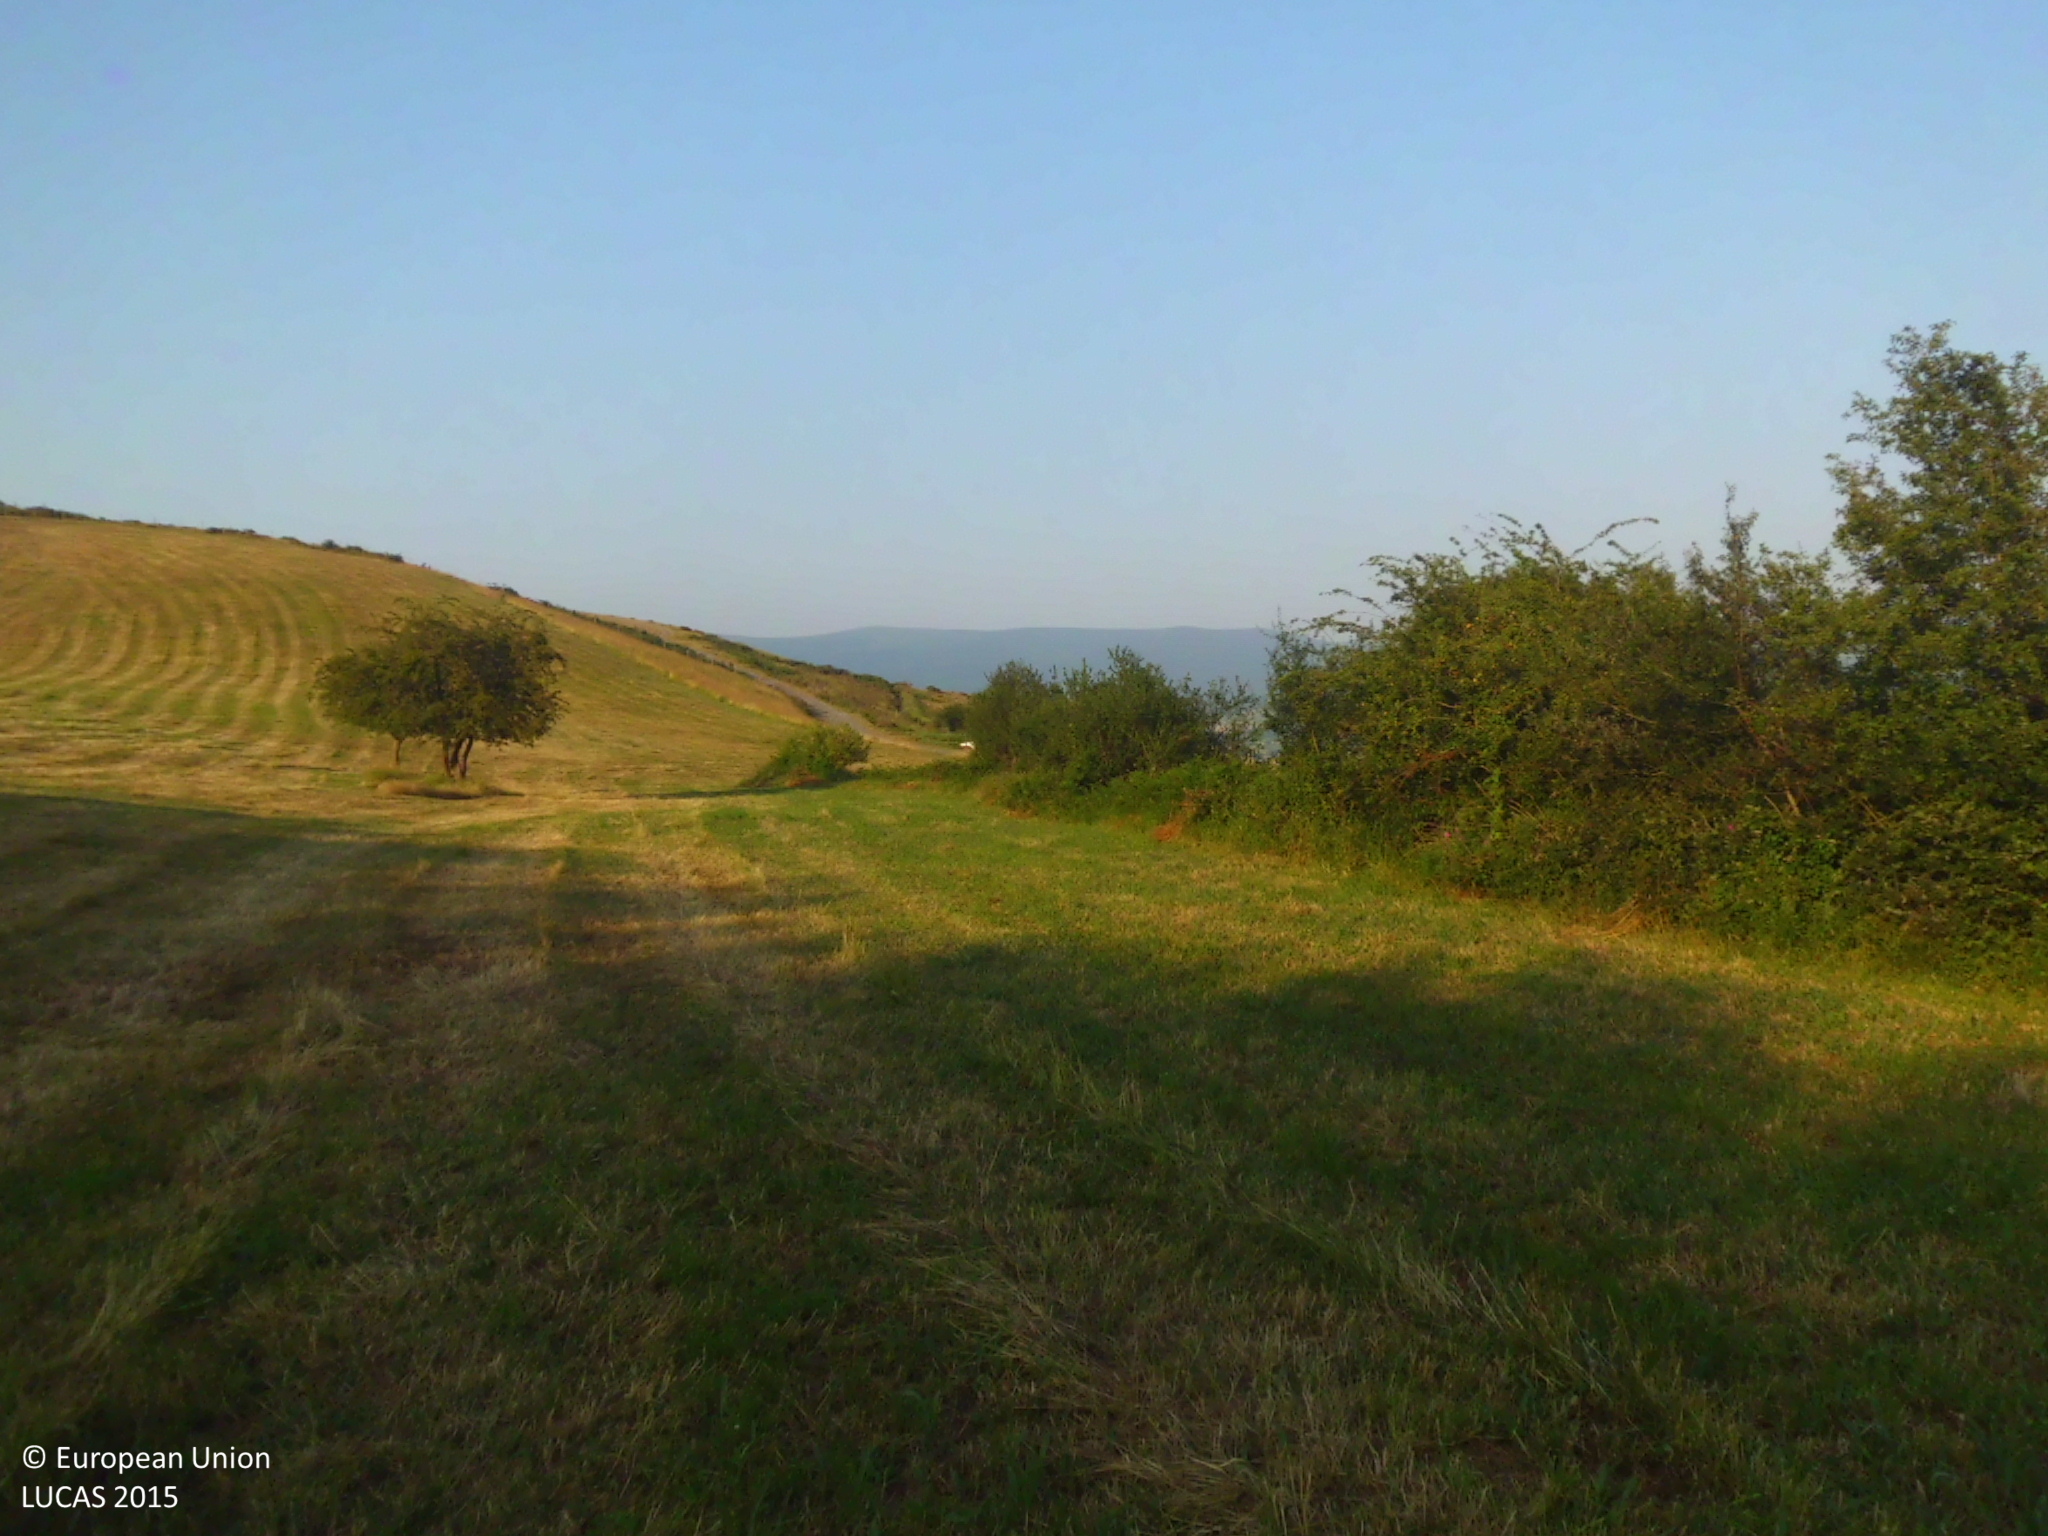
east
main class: Grassland
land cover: Grassland without tree/shrub cover
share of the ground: > 75 %
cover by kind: herbaceous plants 95 %, shrubs 5 %
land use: Agriculture (excluding fallow land and kitchen gardens)
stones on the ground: < 10 %
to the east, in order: Grassland without tree/shrub cover; Abandoned hedges; Grassland without tree/shrub cover; Grassland with sparse tree/shrub cover; Fences; Tracks; Grassland with sparse tree/shrub cover; Tracks; Grassland with sparse tree/shrub cover; Other bare soil; Broadleaved woodland
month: June
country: ES
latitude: 43.1294
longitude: -4.0762
